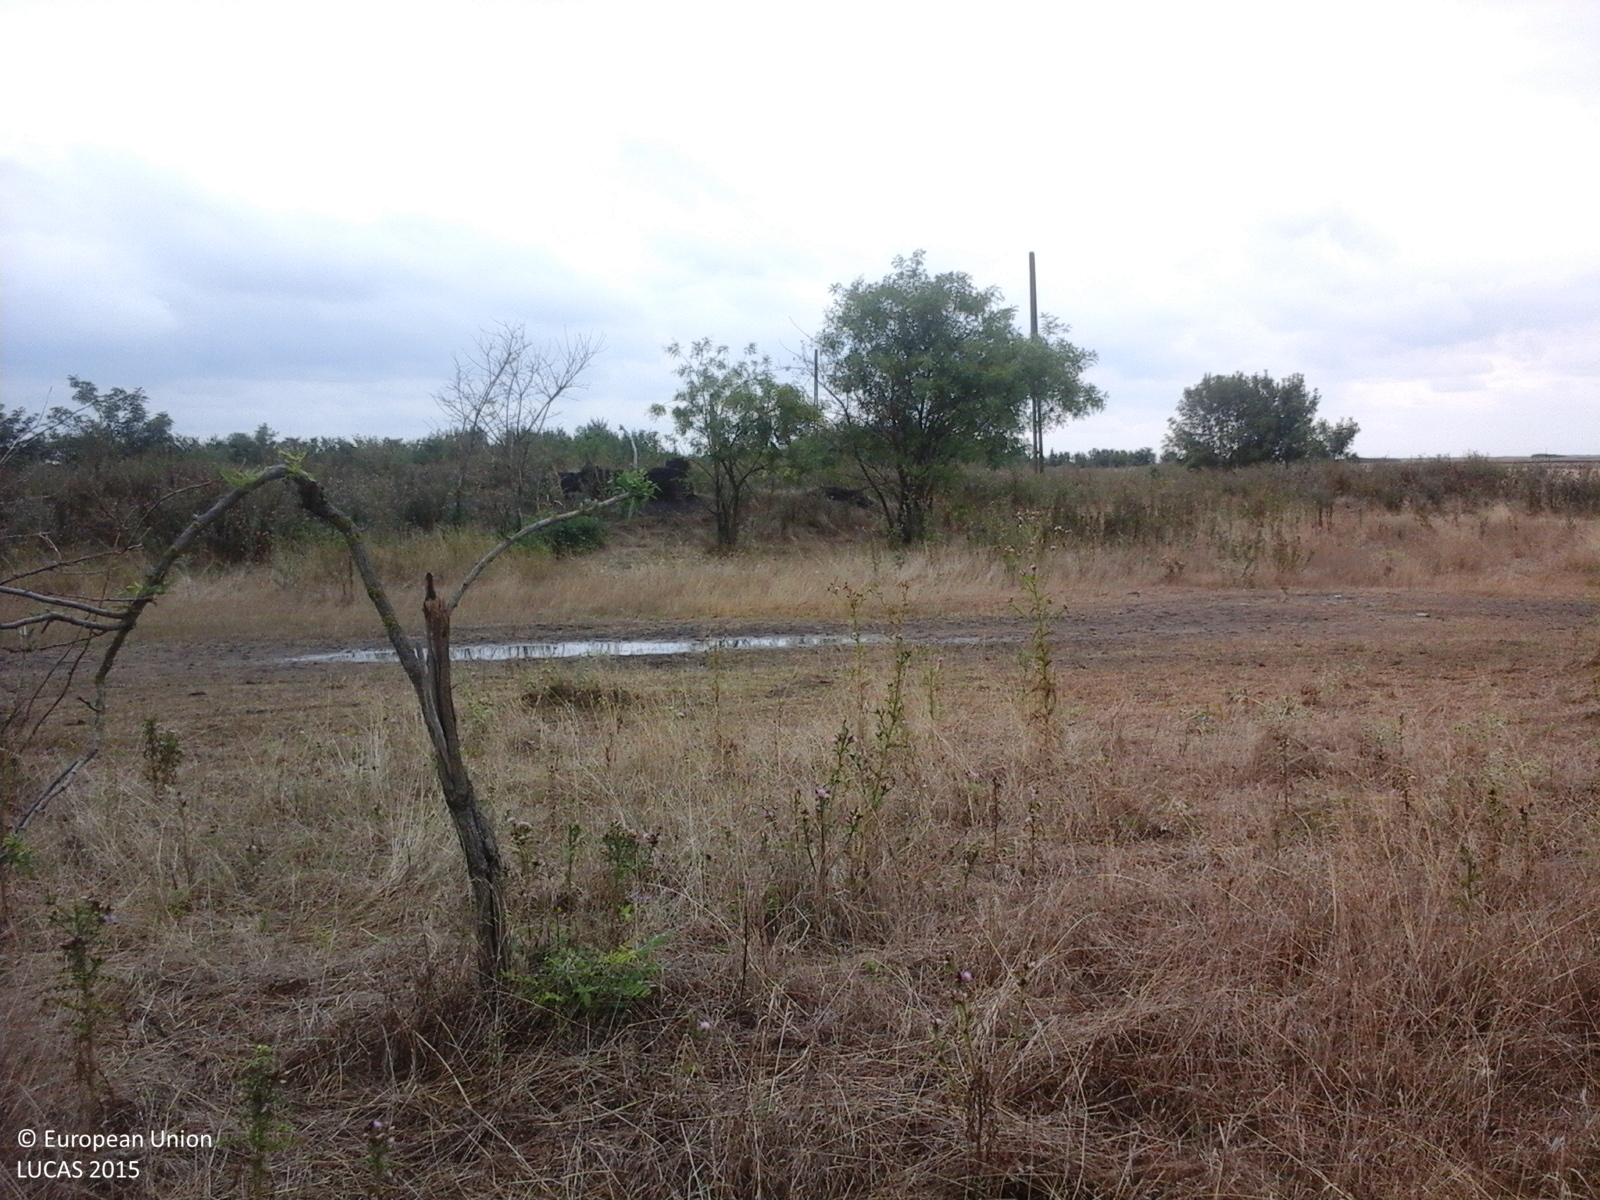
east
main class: Grassland
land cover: Spontaneously vegetated surfaces
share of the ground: > 75 %
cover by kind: herbaceous plants 100 %
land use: Semi-natural and natural areas not in use
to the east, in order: Spontaneously vegetated surfaces; Tracks; Spontaneously vegetated surfaces; Grassland with sparse tree/shrub cover; Spontaneously vegetated surfaces; Grassland with sparse tree/shrub cover; Grassland without tree/shrub cover
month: August
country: RO
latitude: 46.0960
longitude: 20.4104
